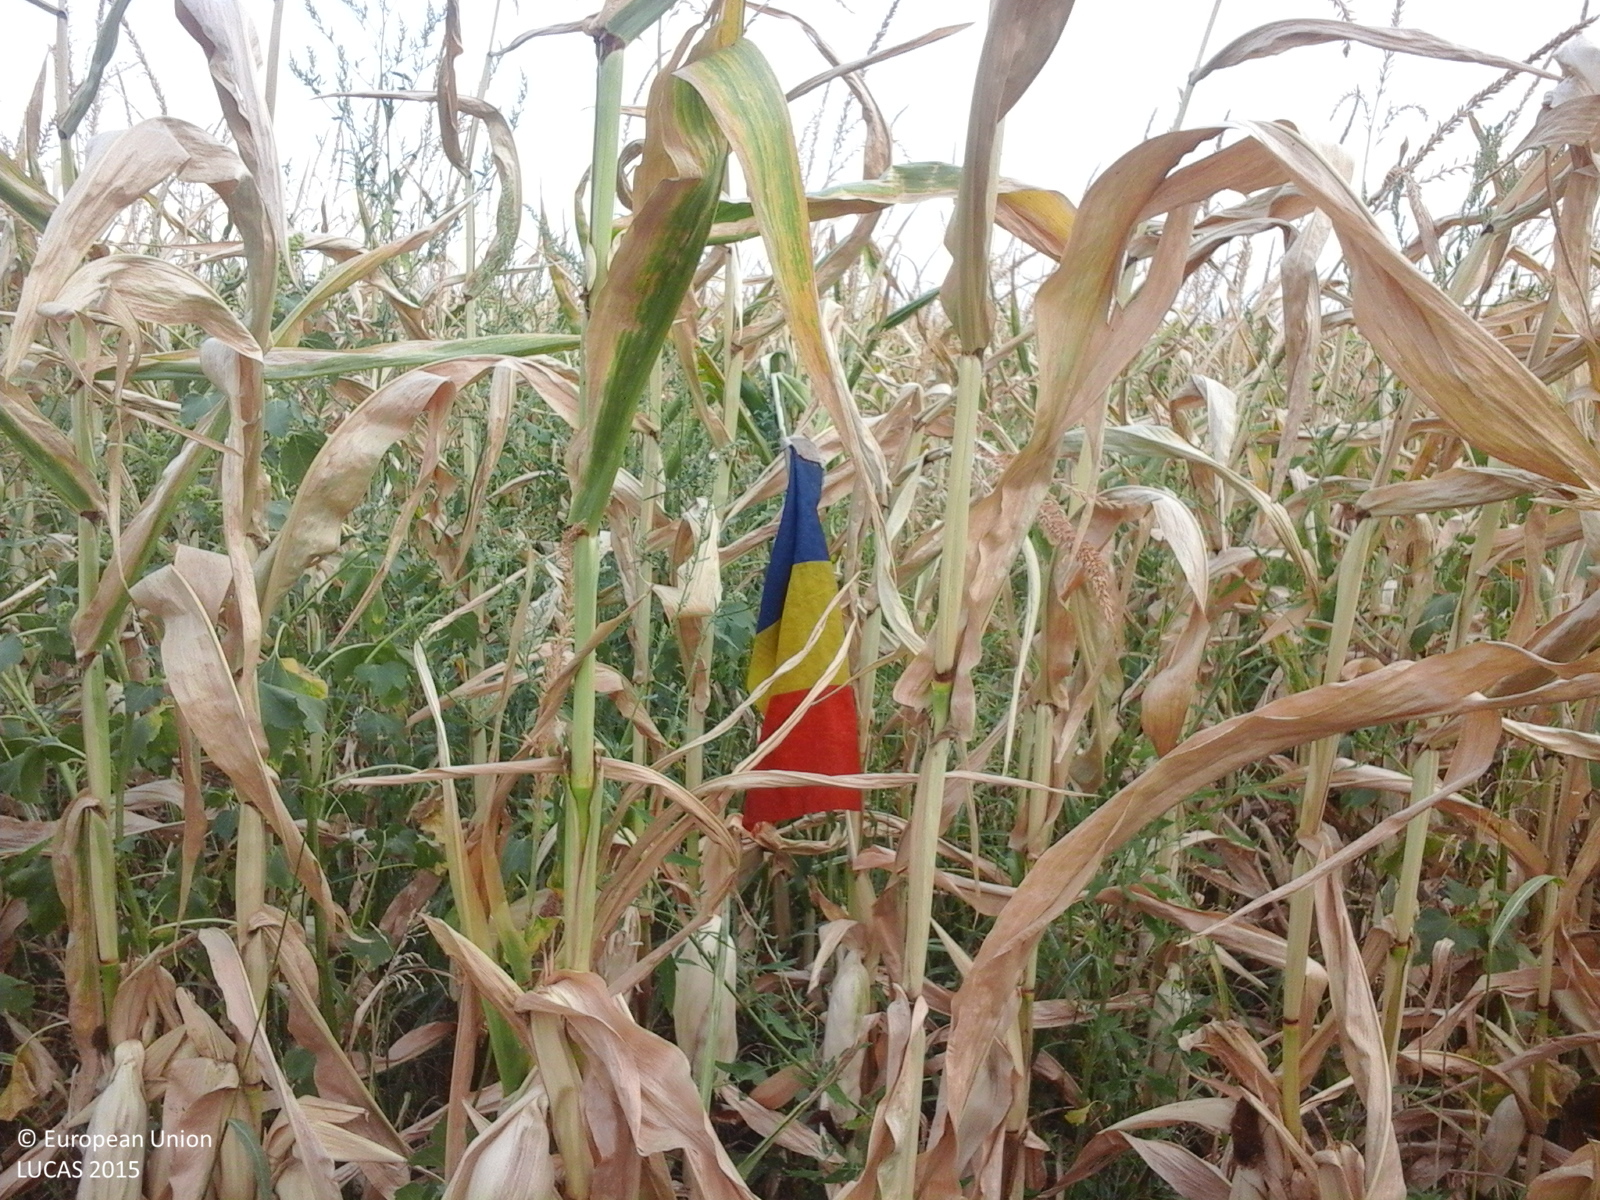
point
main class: Cropland
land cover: Maize
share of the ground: > 75 %
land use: Agriculture (excluding fallow land and kitchen gardens)
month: August
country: RO
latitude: 43.9460
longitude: 23.1634
